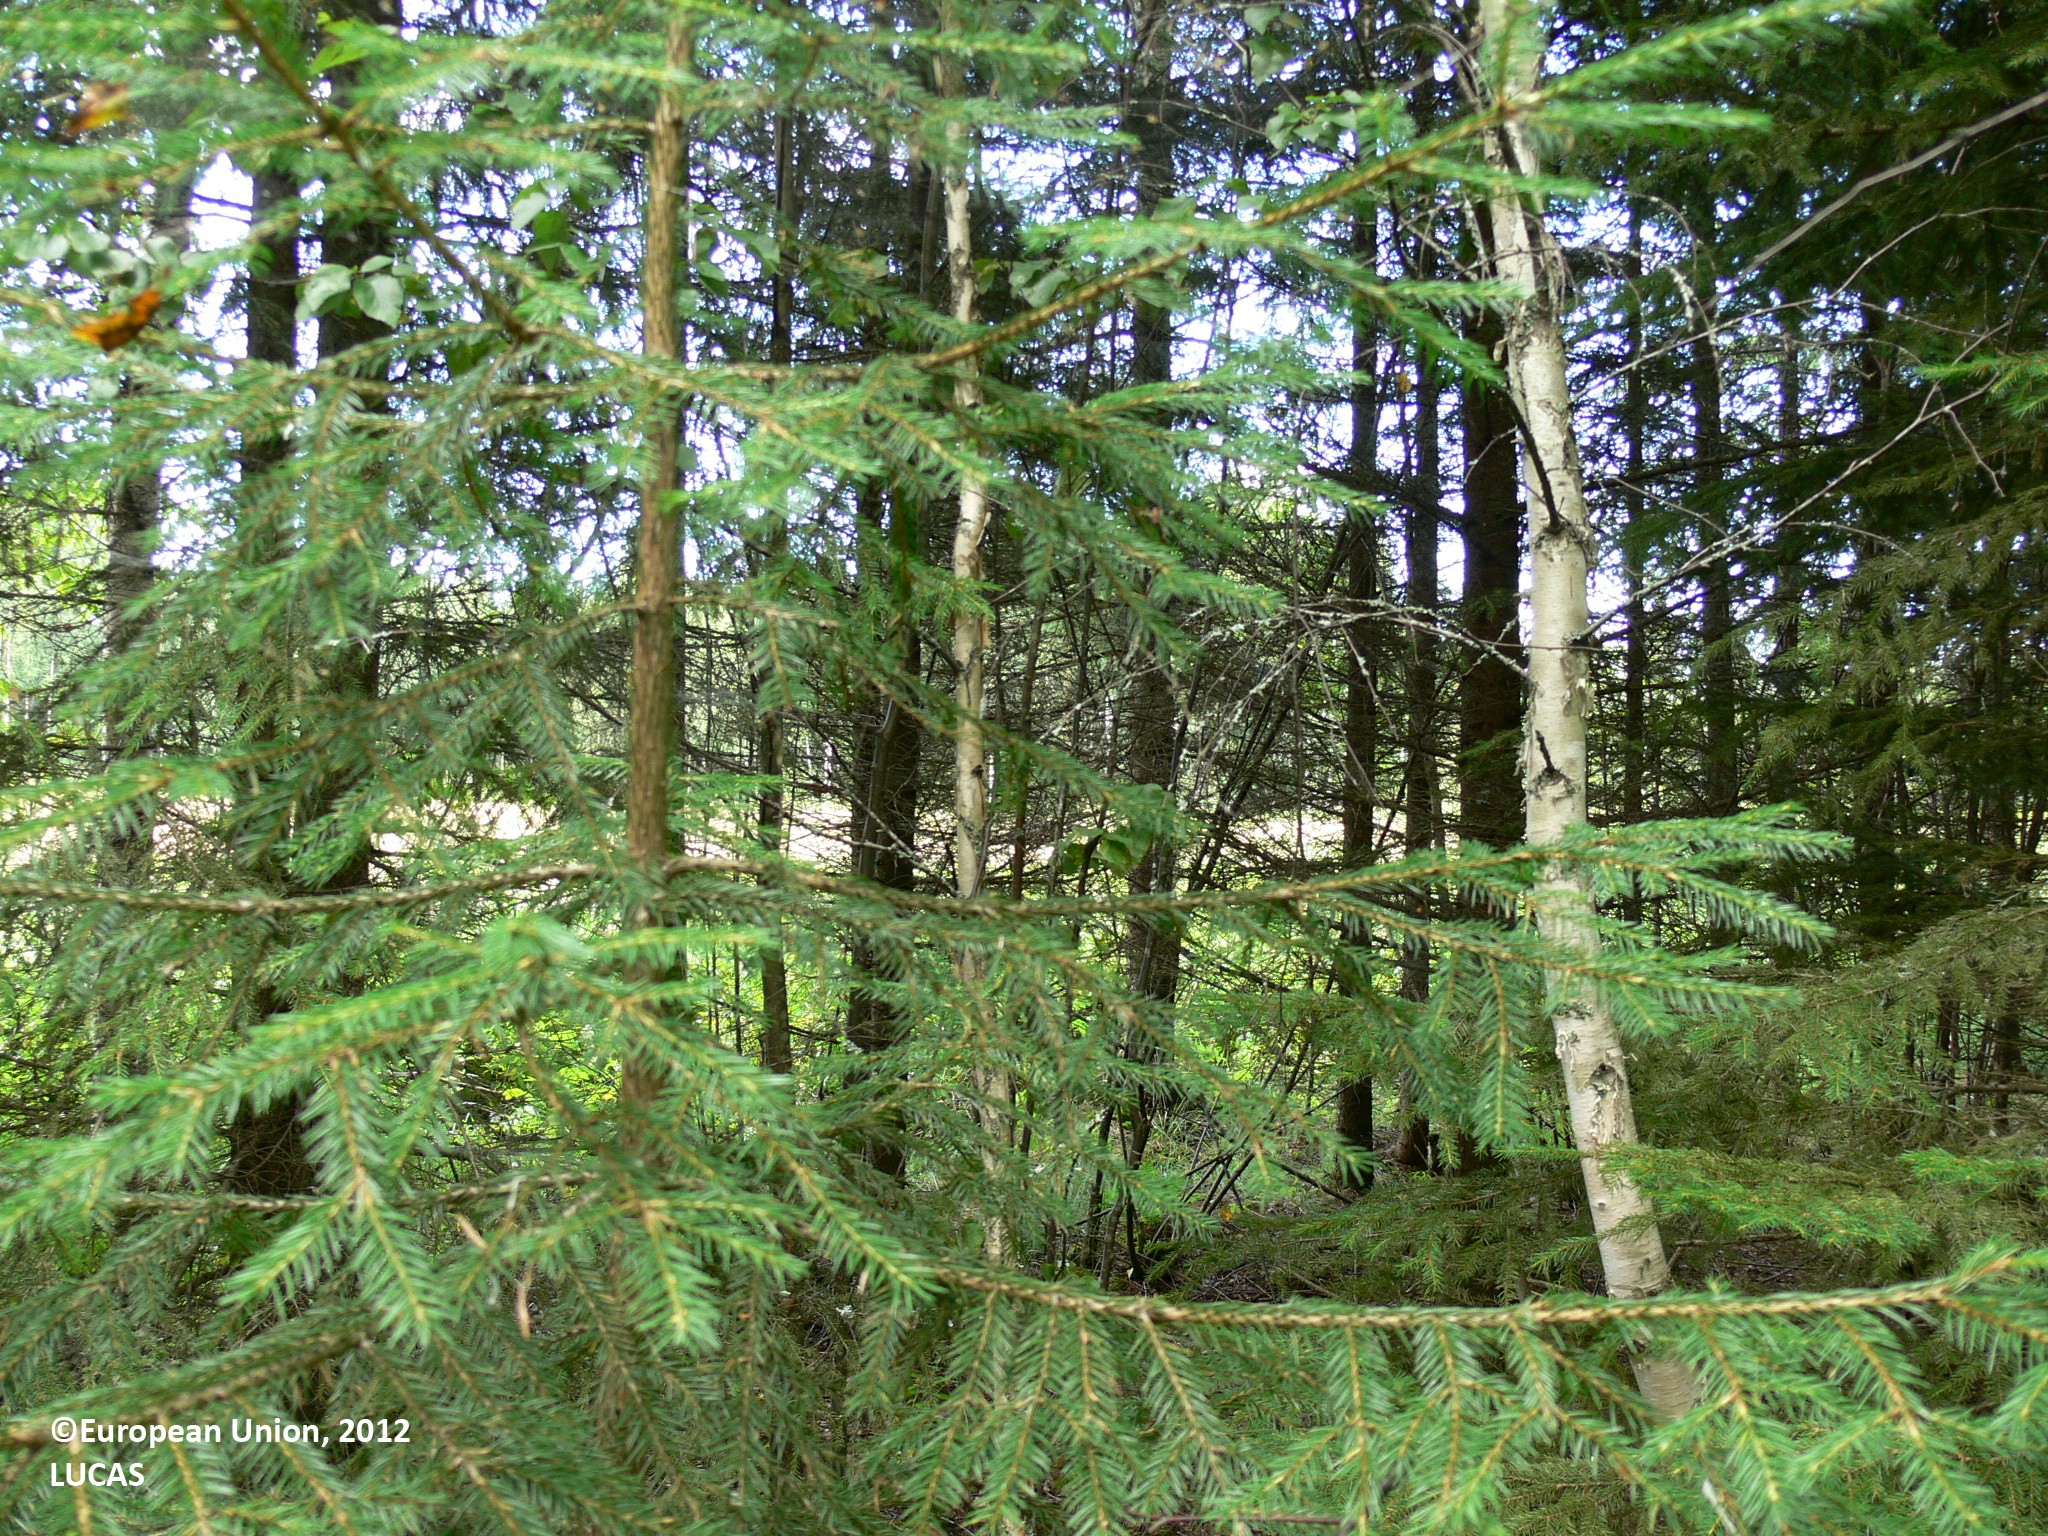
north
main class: Woodland
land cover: Spruce dominated mixed woodland
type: boreal forest
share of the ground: > 75 %
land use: Forestry
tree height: > 5 m
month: July
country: FI
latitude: 62.0260
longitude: 30.0469
